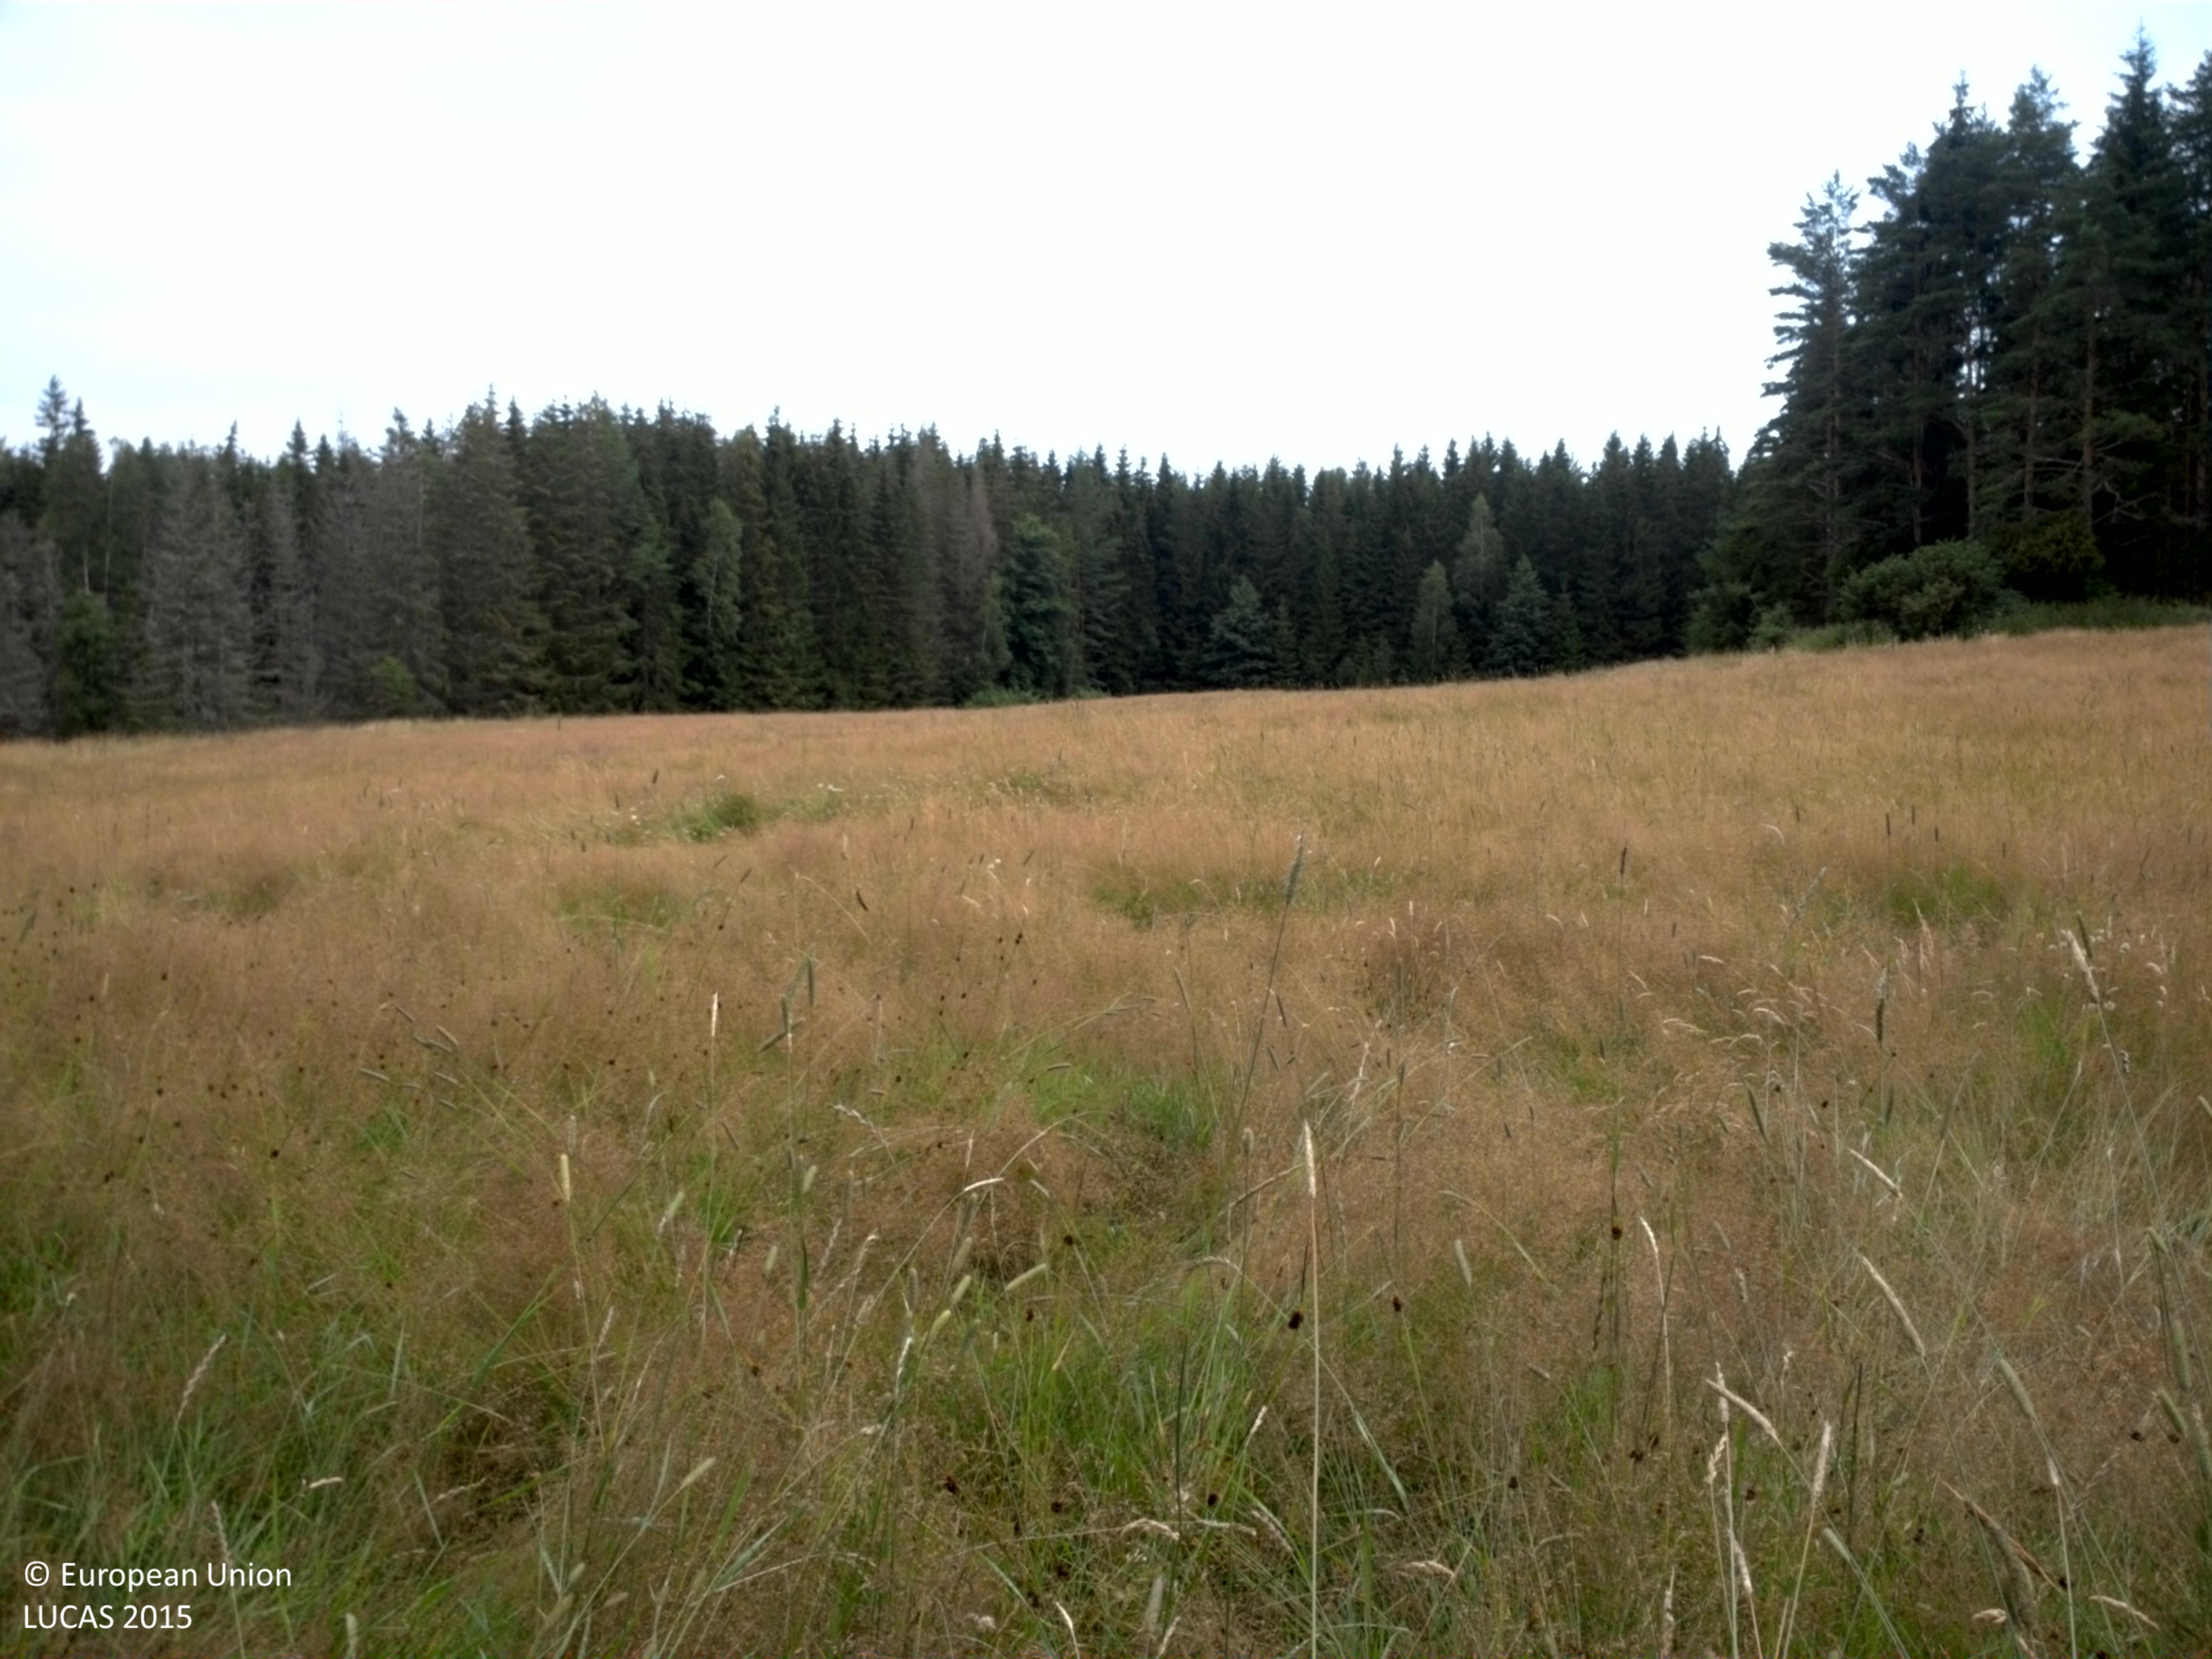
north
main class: Cropland
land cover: Temporary grasslands
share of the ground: > 75 %
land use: Agriculture (excluding fallow land and kitchen gardens)
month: August
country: SE
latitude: 59.3216
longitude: 11.9104
